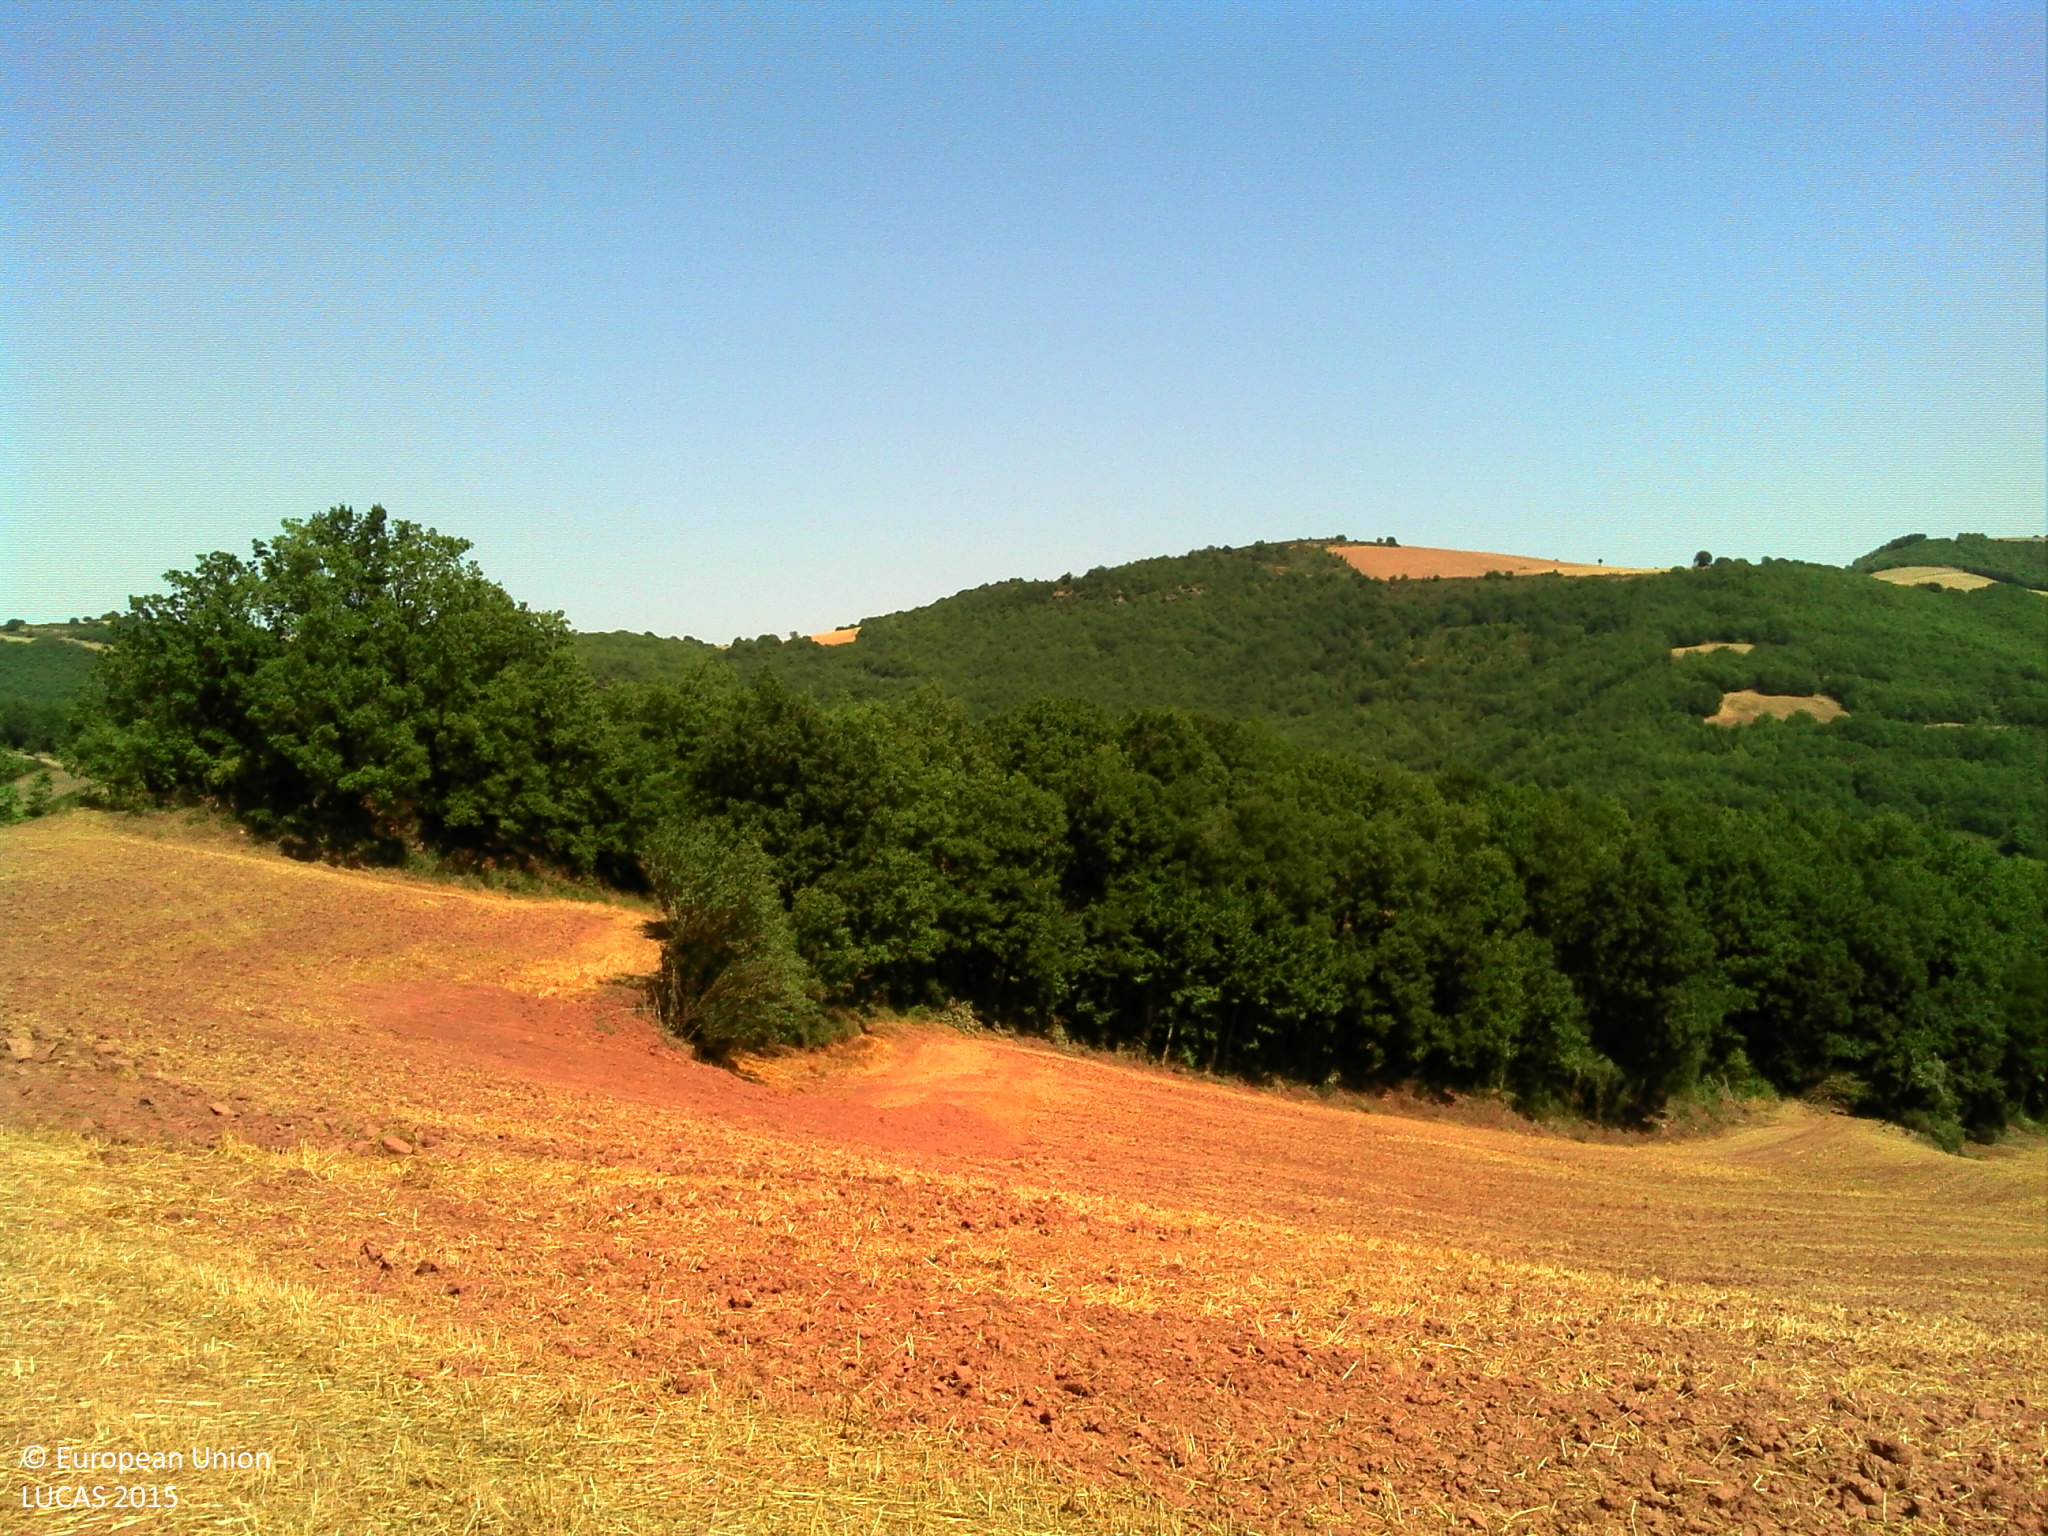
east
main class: Cropland
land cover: Barley
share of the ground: 25 - 50 %
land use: Agriculture (excluding fallow land and kitchen gardens)
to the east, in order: Barley; Broadleaved woodland; Temporary grasslands; Broadleaved woodland; Tracks; Broadleaved woodland; Other bare soil
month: August
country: FR
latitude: 43.8169
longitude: 2.6334
